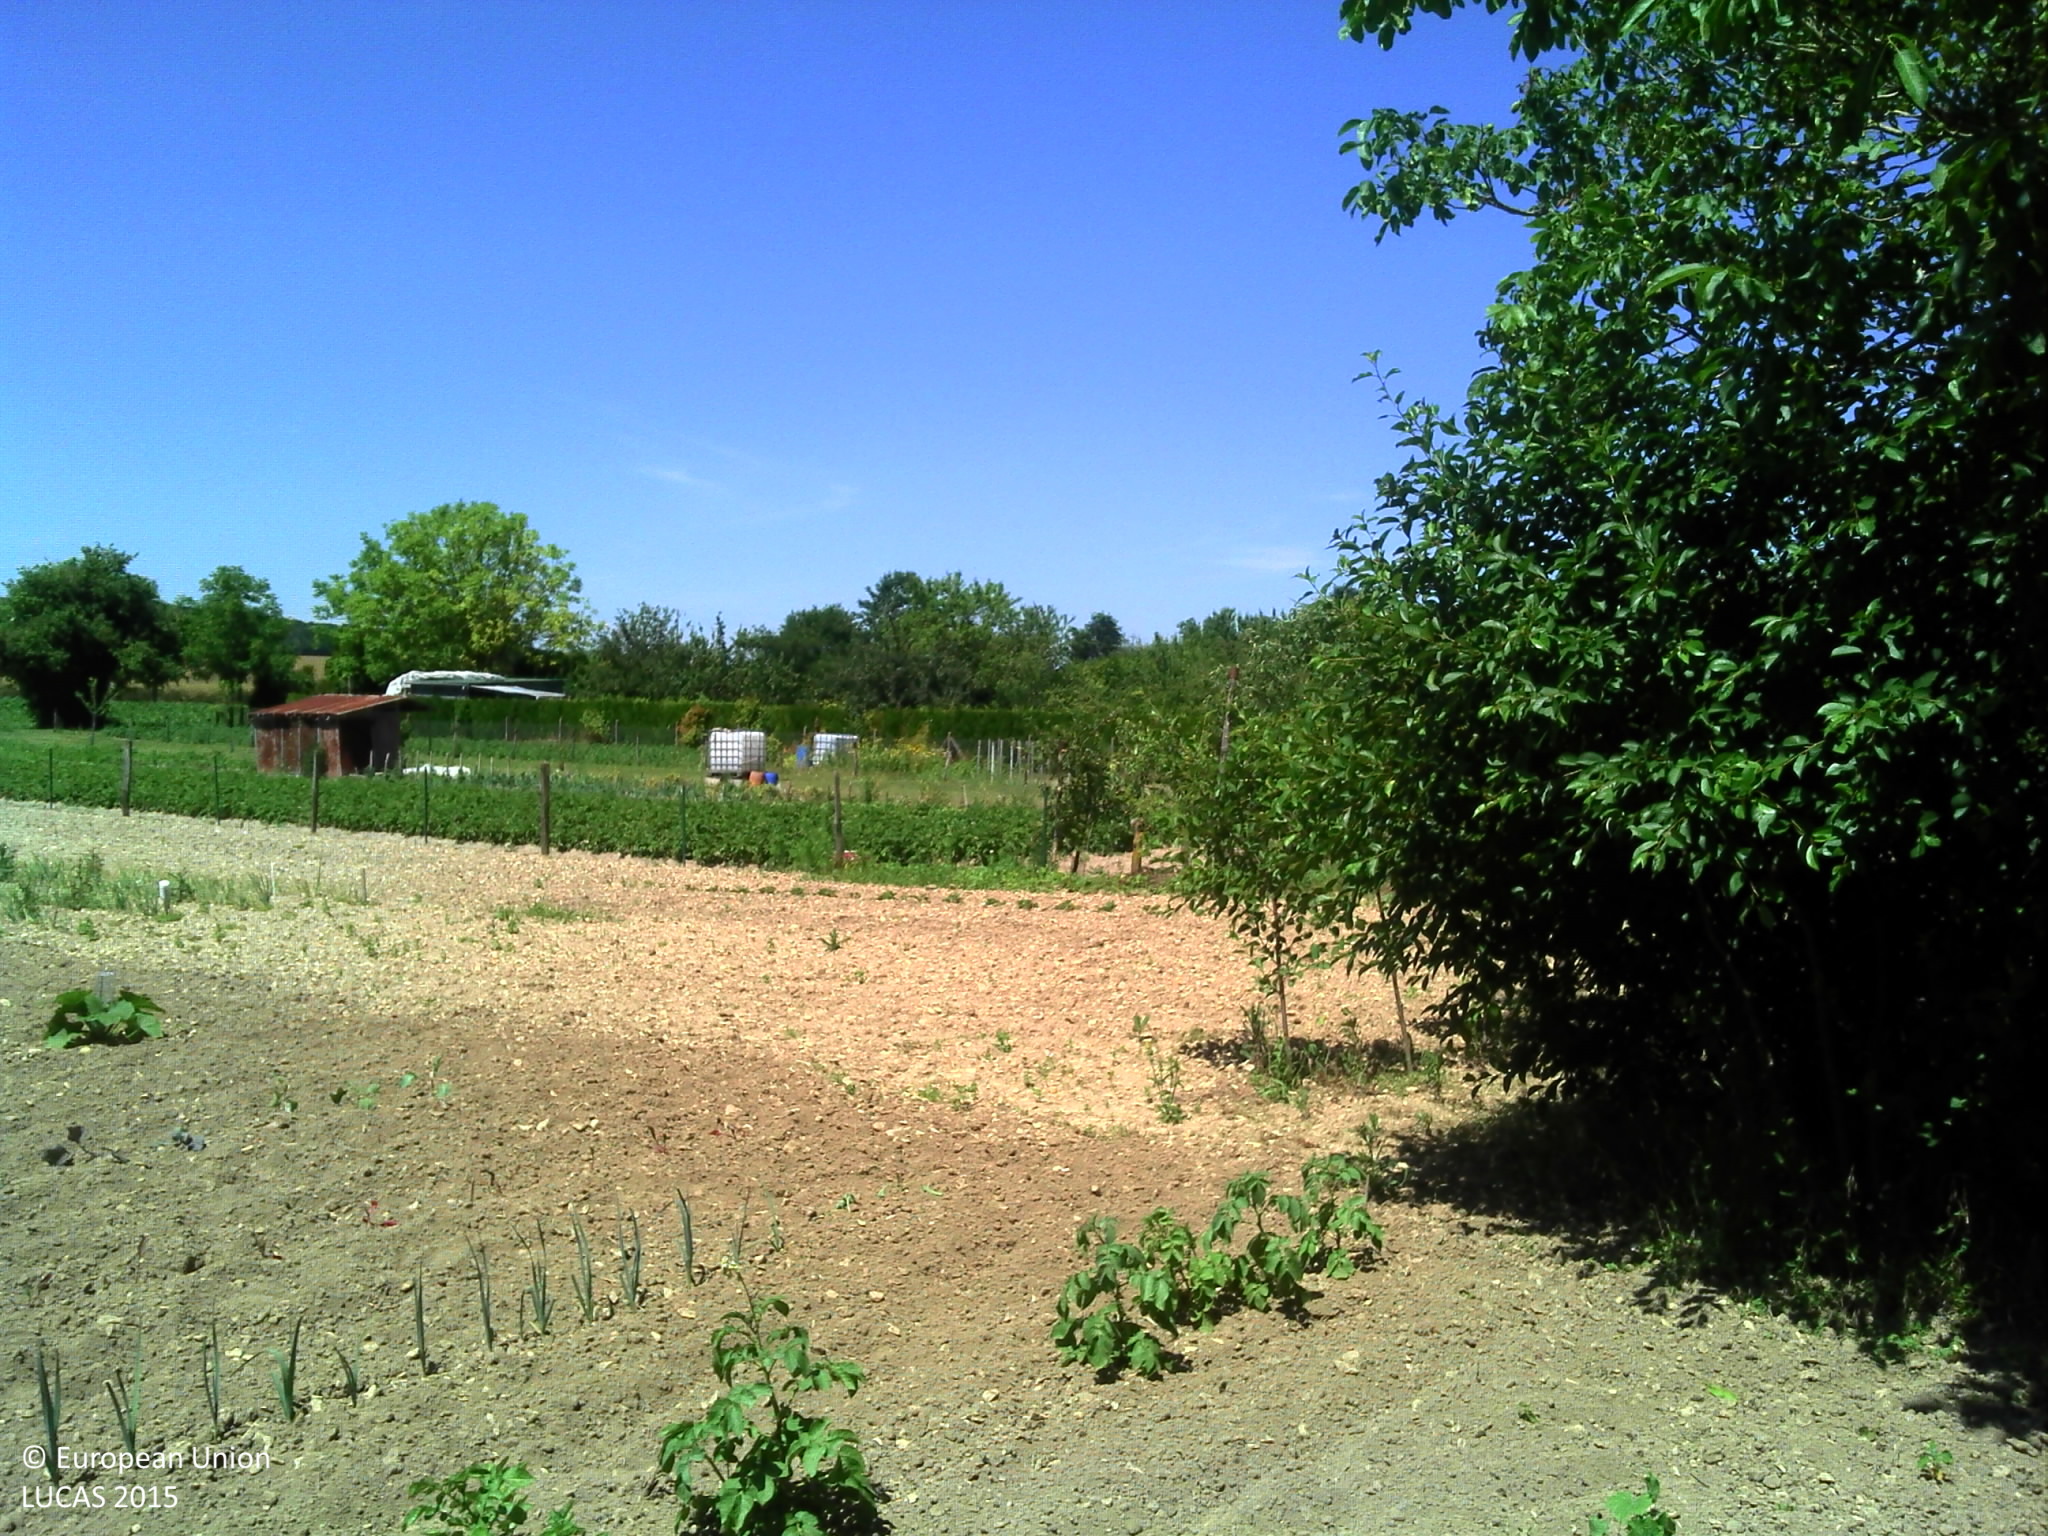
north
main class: Cropland
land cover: Other fresh vegetables
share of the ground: > 75 %
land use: Kitchen garden
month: June
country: FR
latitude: 47.1270
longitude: 2.6247
